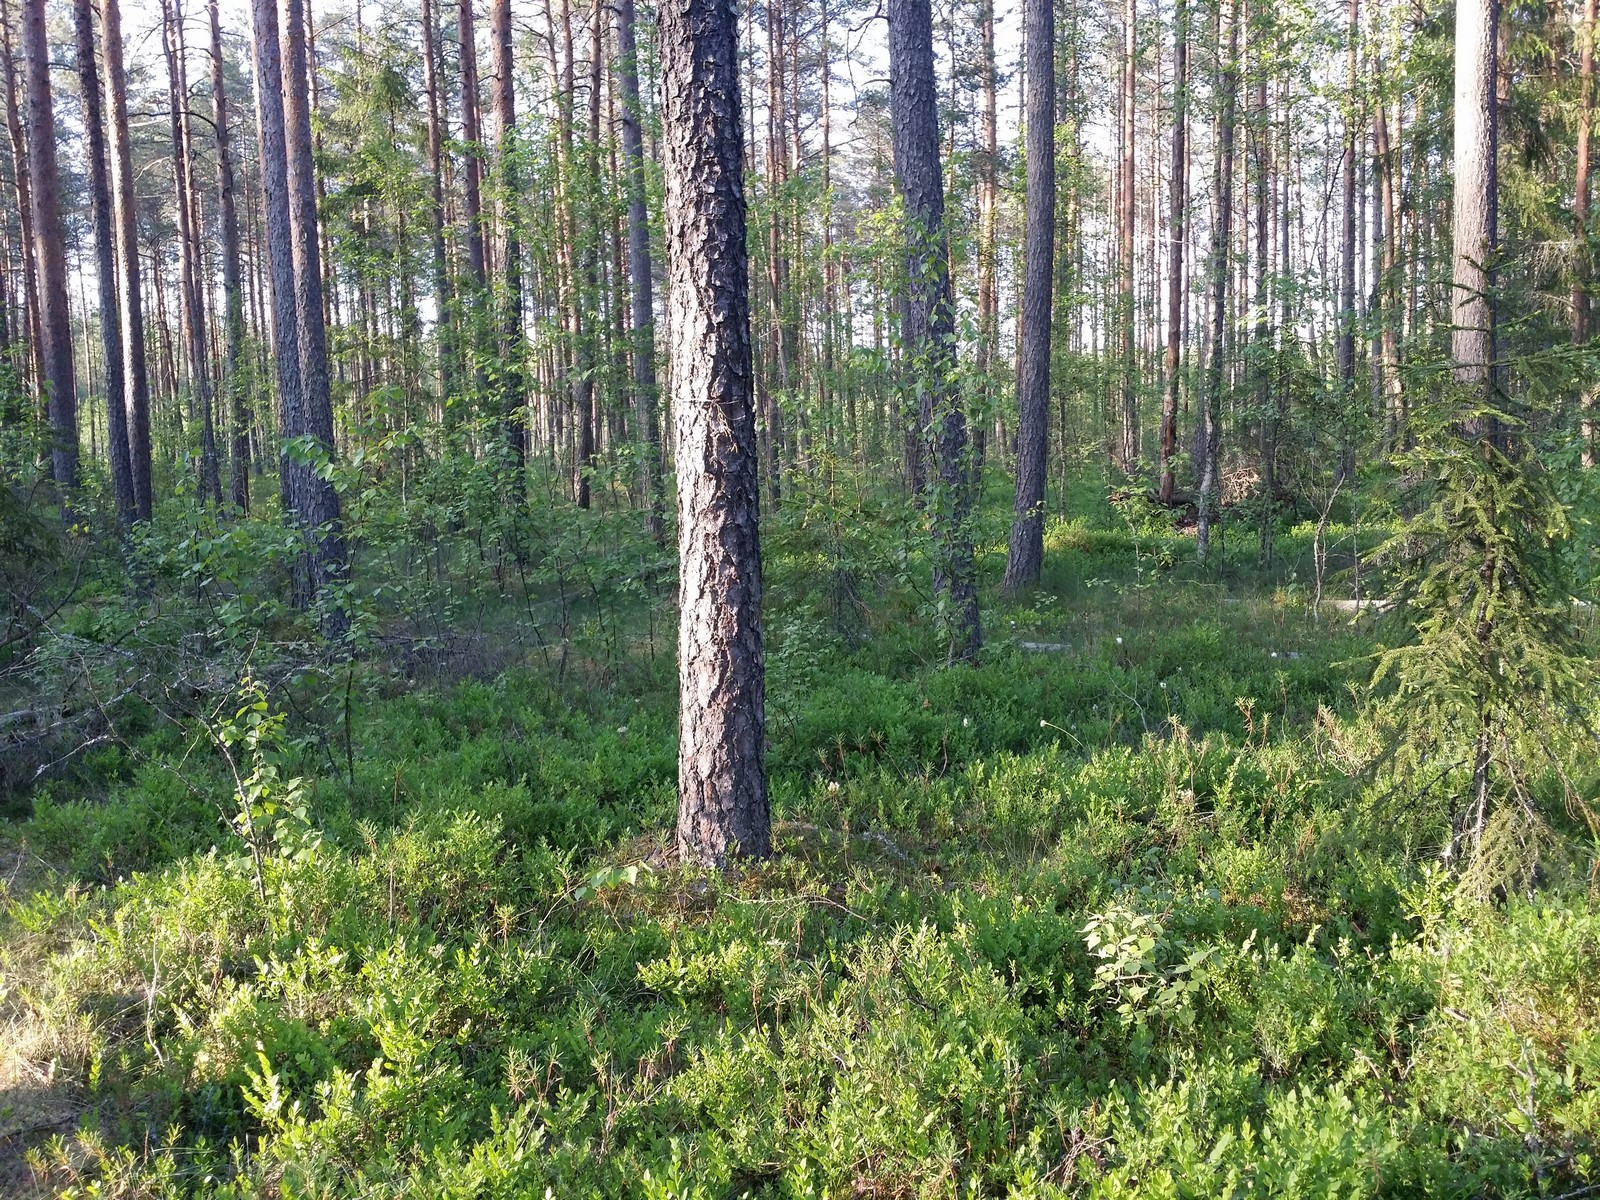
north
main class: Woodland
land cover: Other coniferous woodland
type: hemiboreal forest and nemoral coniferous forest and mixed broadleaved-coniferous forest
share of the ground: > 75 %
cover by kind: coniferous forest trees 80 %, lichens and mosses 20 %
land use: Forestry
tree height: > 5 m
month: June
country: LV
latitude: 57.2787
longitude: 26.5156
